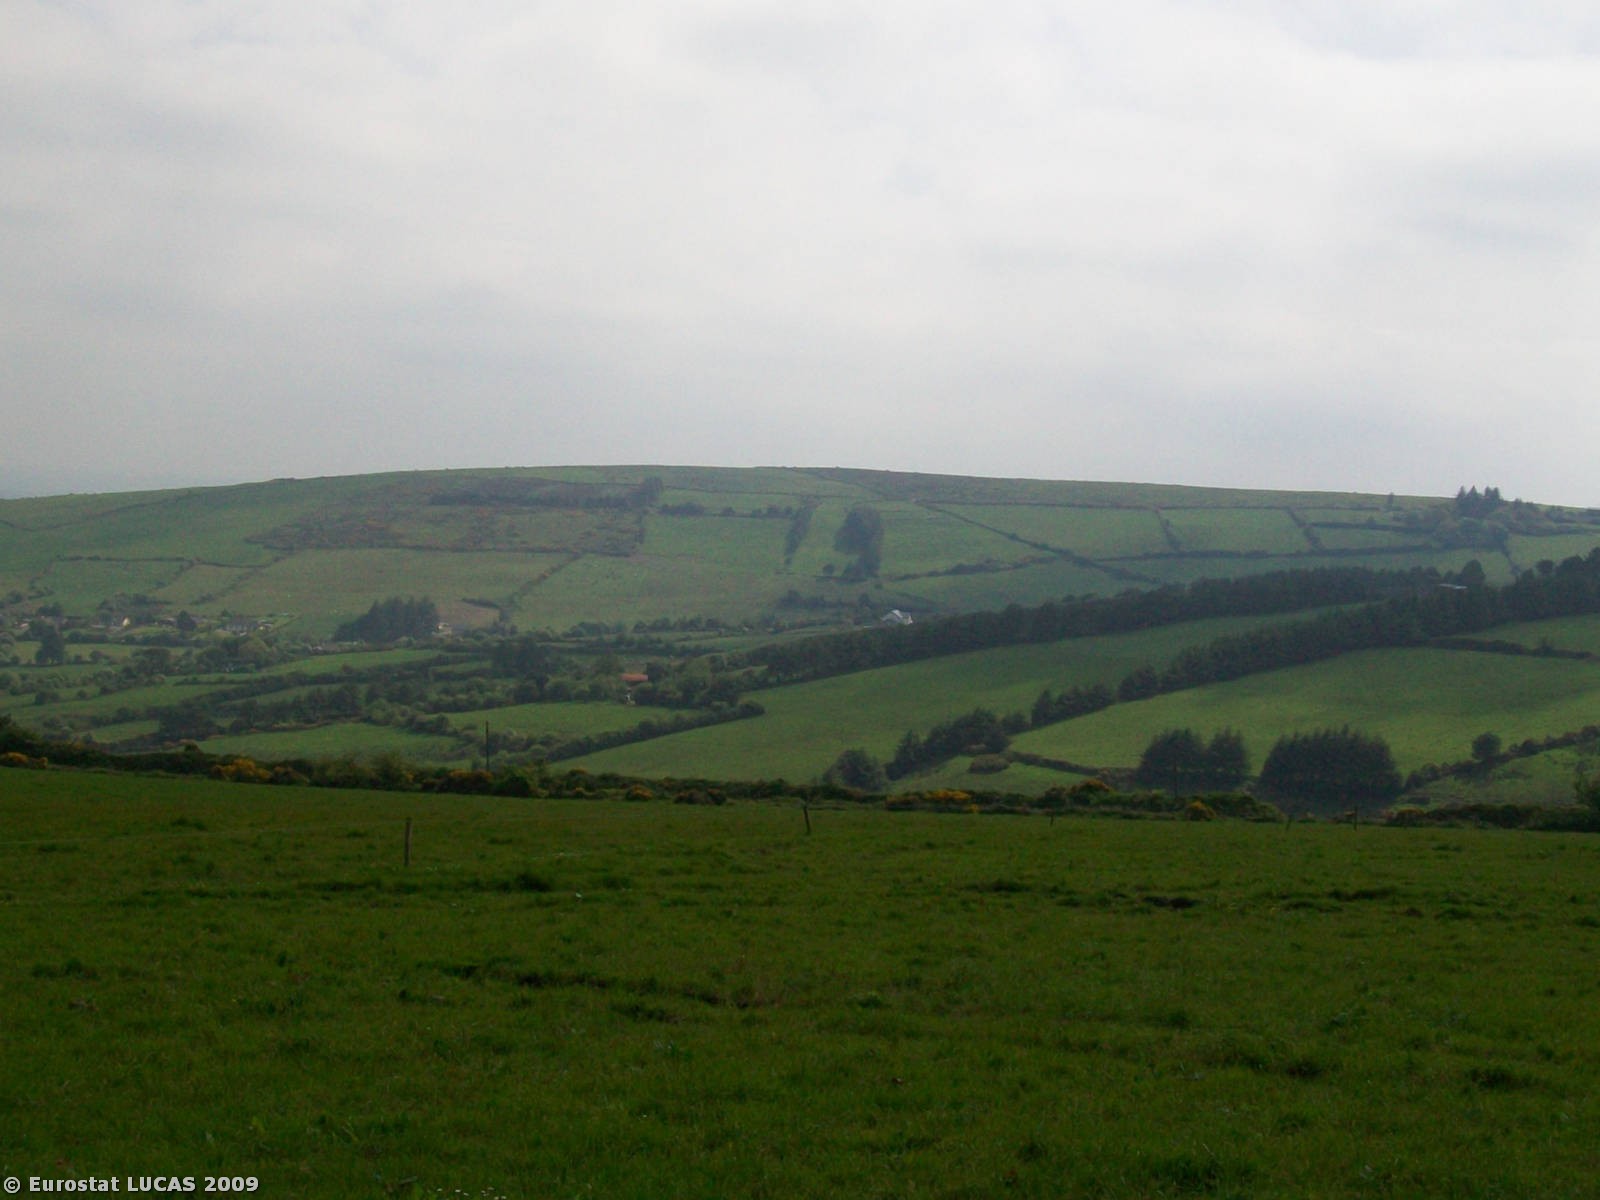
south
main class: Grassland
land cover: Grassland without tree/shrub cover
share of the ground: > 75 %
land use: Agriculture (excluding fallow land and kitchen gardens)
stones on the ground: < 10 %
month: May
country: IE
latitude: 52.0222
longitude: -8.7854
